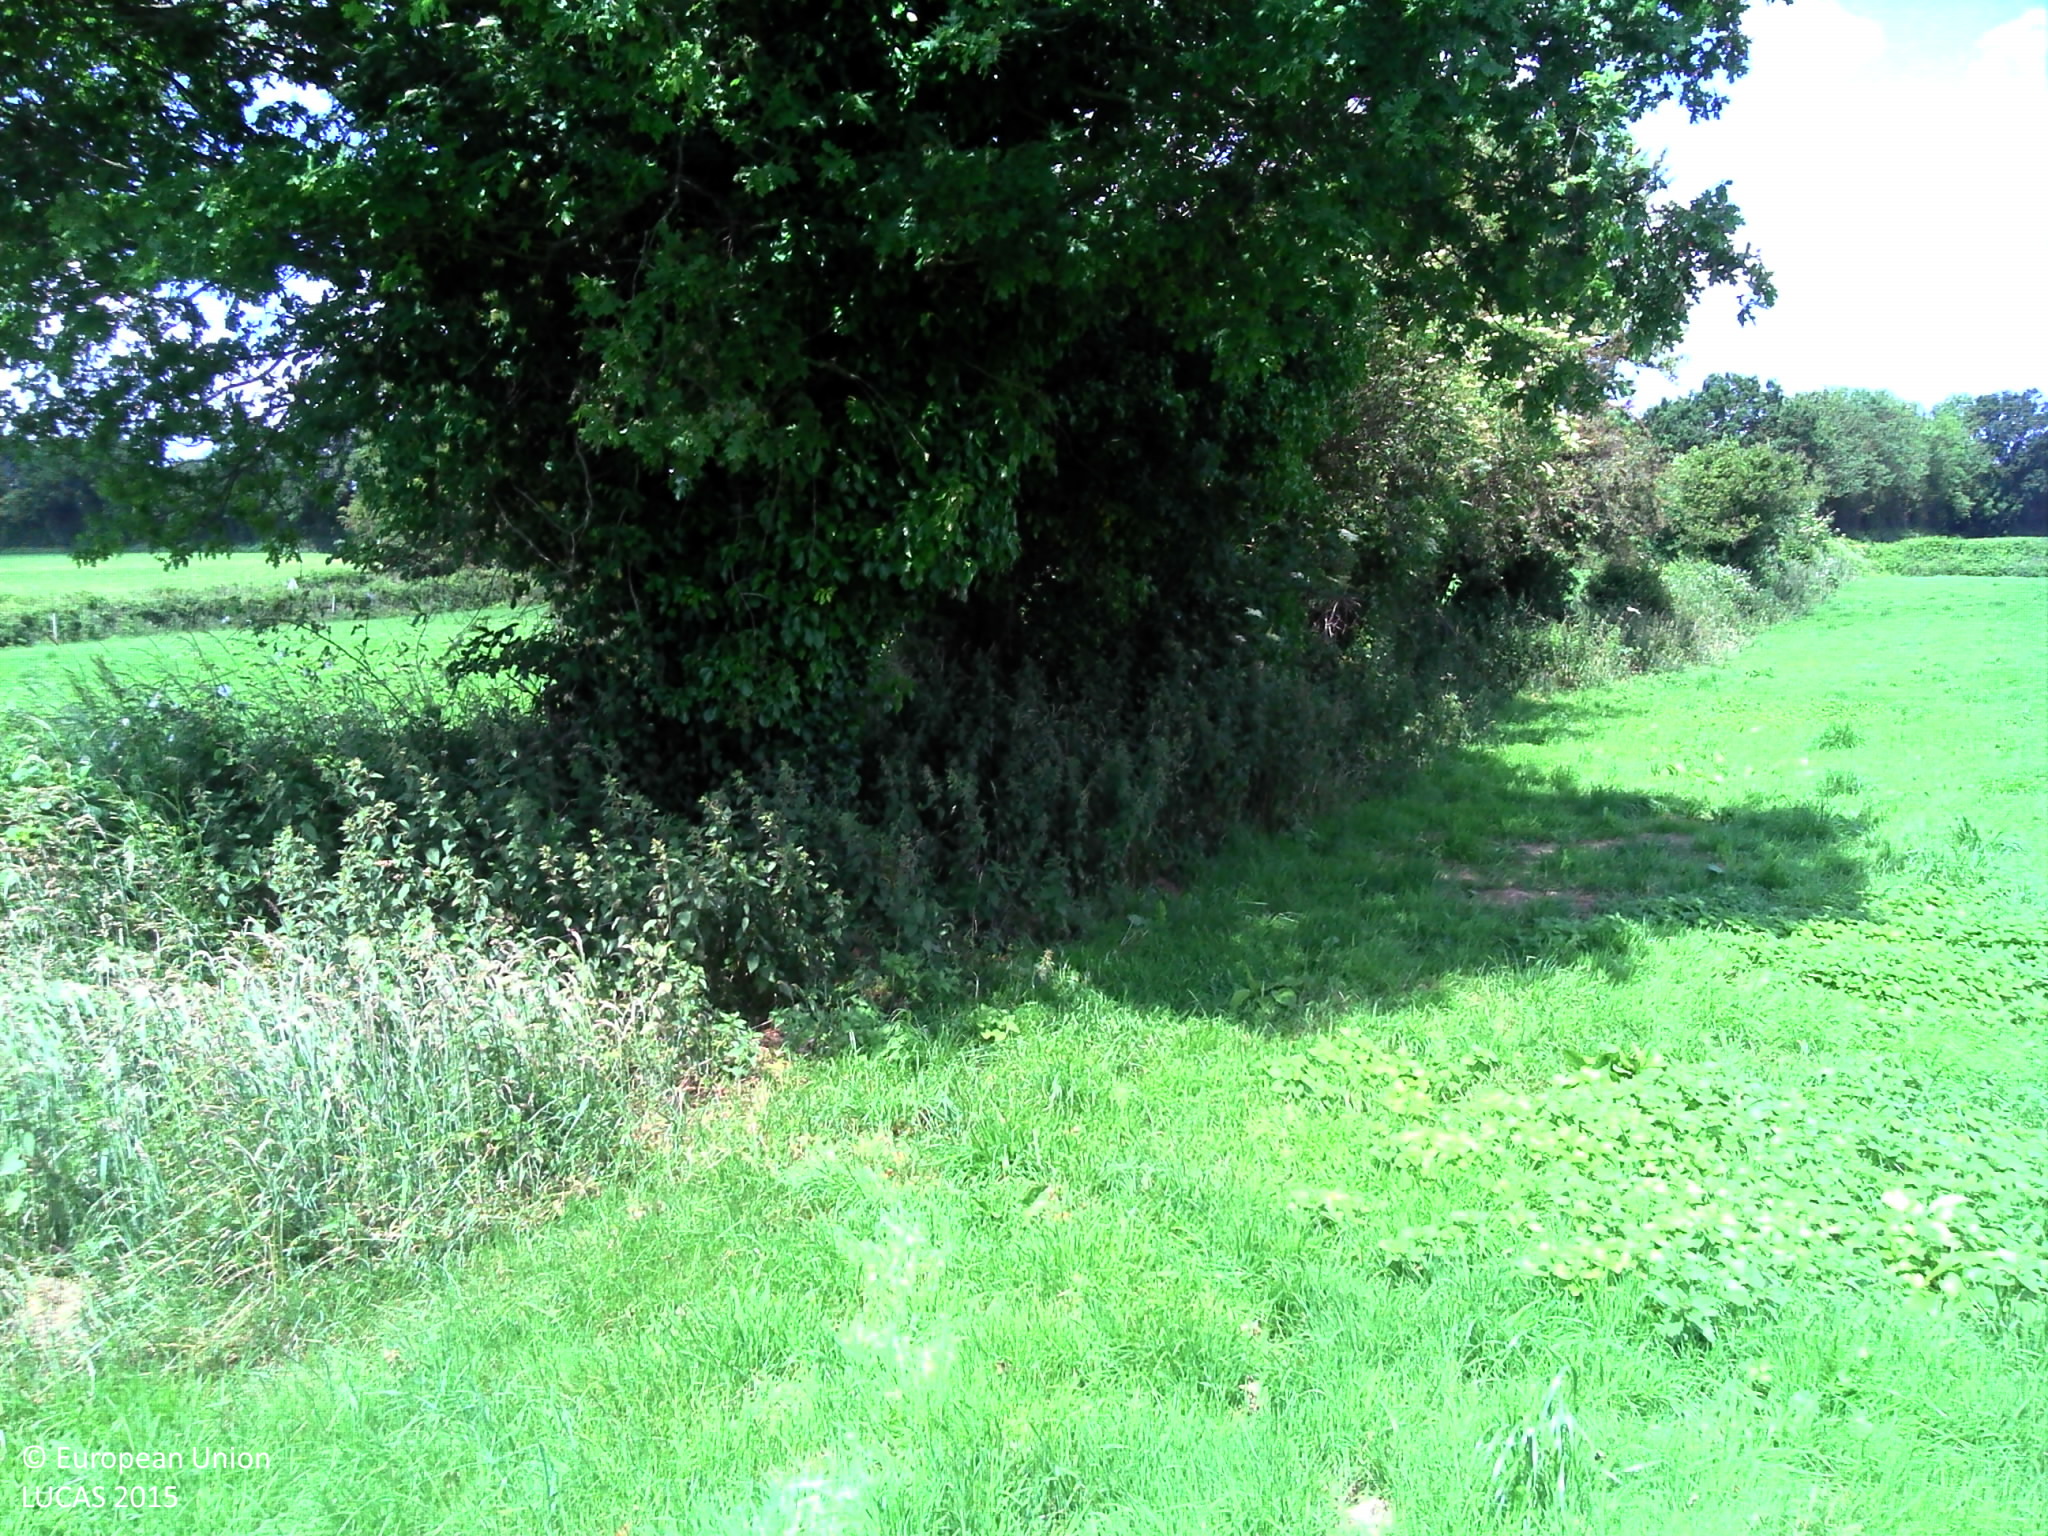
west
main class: Grassland
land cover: Grassland without tree/shrub cover
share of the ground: > 75 %
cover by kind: herbaceous plants 100 %
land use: Agriculture (excluding fallow land and kitchen gardens)
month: June
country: FR
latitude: 49.2639
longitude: -1.4123
